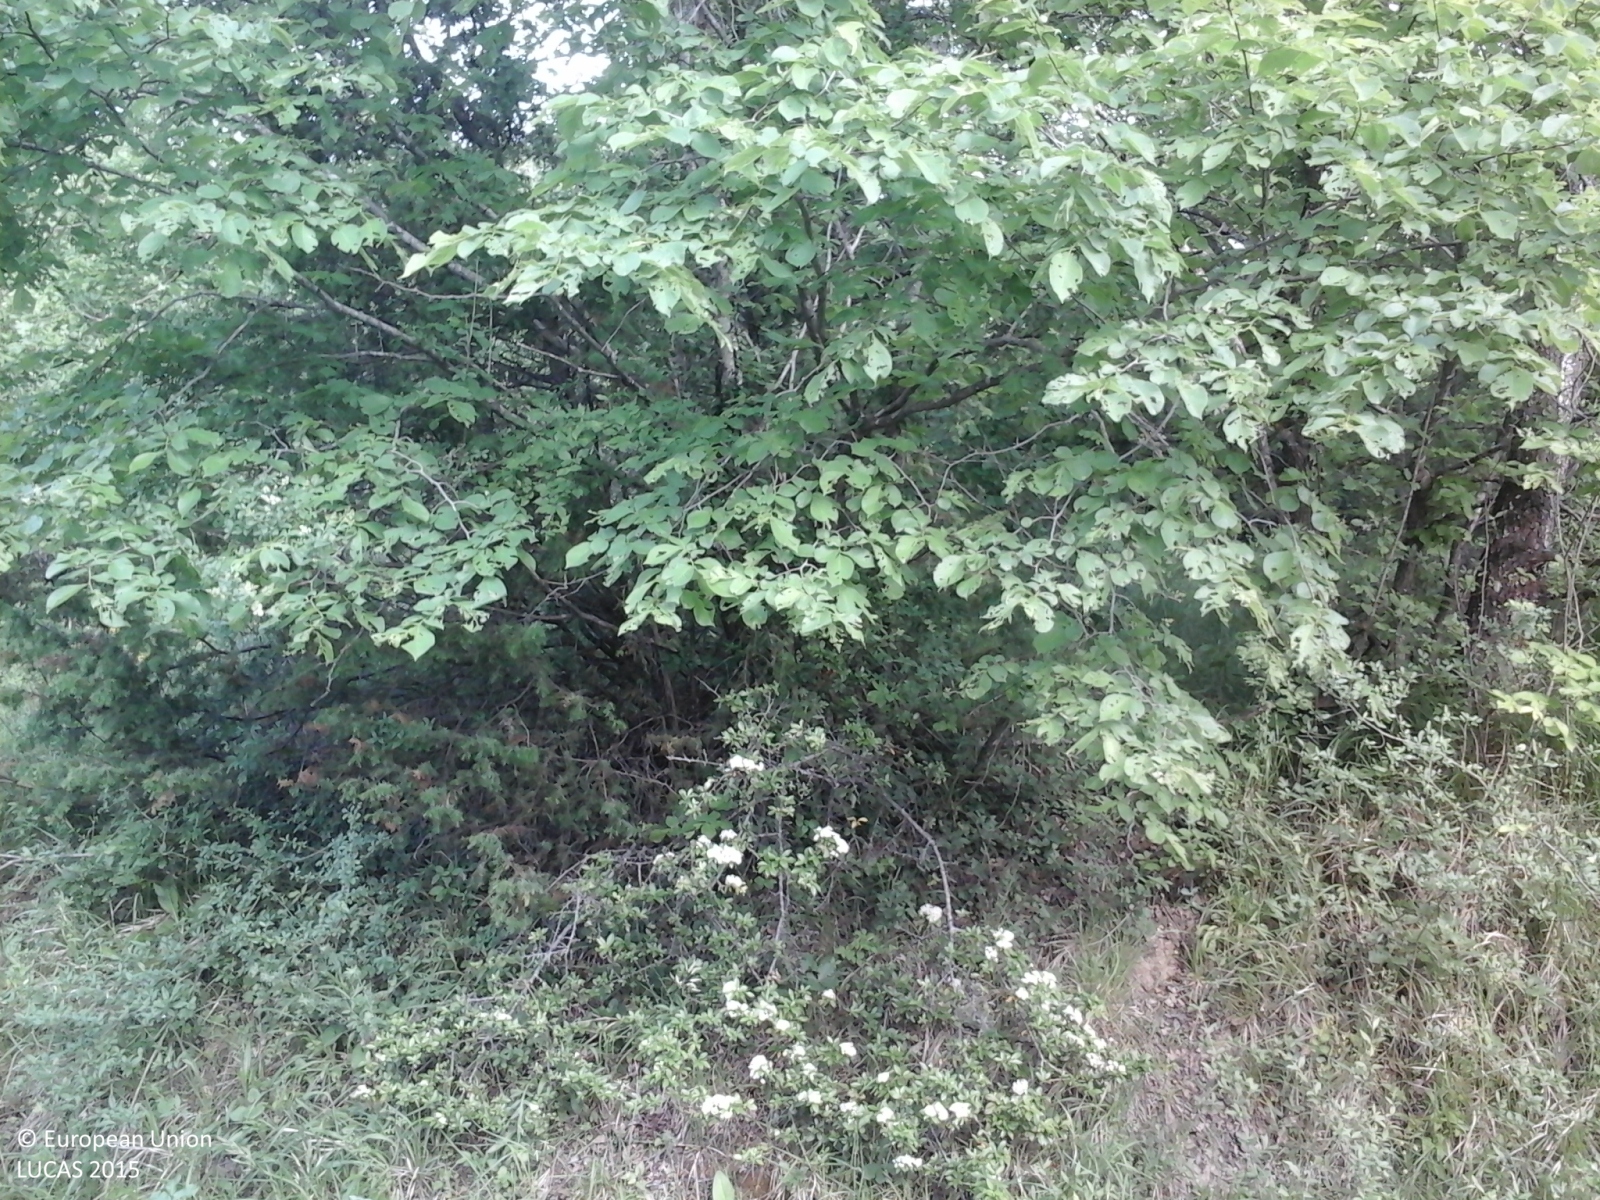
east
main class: Woodland
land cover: Broadleaved woodland
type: thermophilous deciduous forest
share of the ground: > 75 %
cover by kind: broadleaved forest trees 85 %, shrubs 10 %, herbaceous plants 5 %
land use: Forestry
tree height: > 5 m
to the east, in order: Broadleaved woodland; Paved roads, cycling and walking lanes; Broadleaved woodland
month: May
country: IT
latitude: 44.2355
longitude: 11.1867
